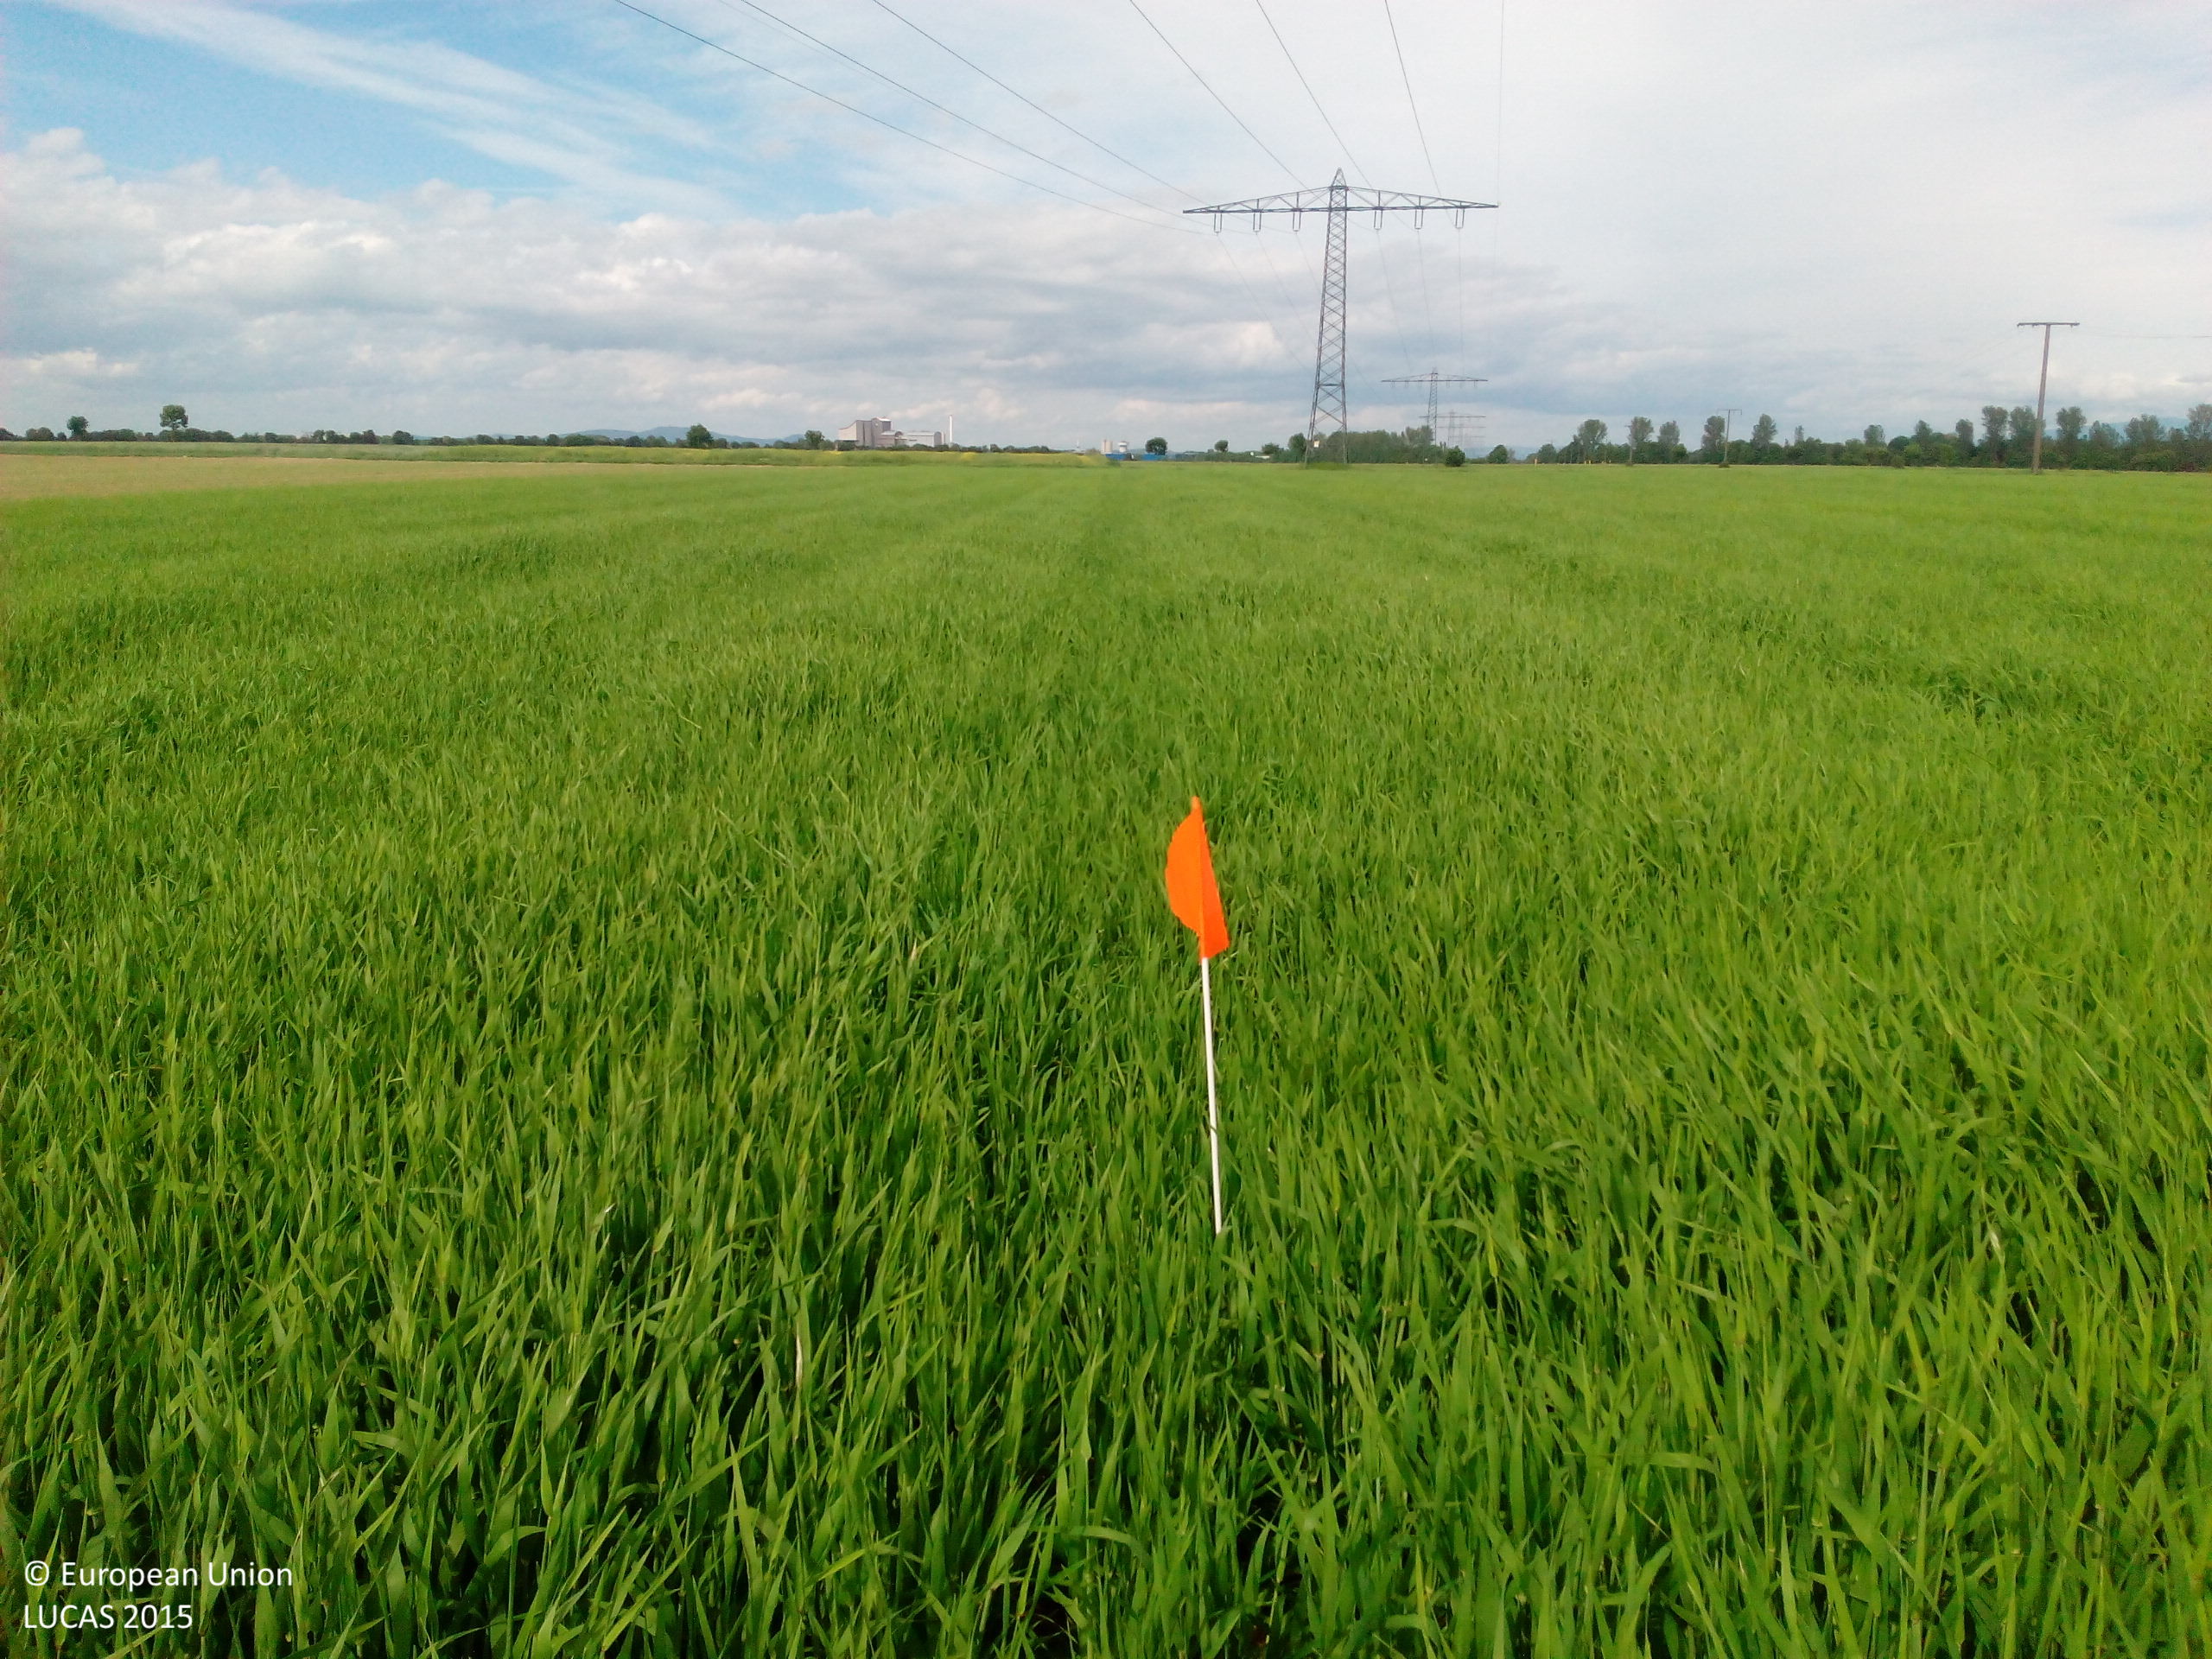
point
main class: Cropland
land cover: Barley
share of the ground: > 75 %
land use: Agriculture (excluding fallow land and kitchen gardens)
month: May
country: DE
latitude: 47.8735
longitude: 7.6081
